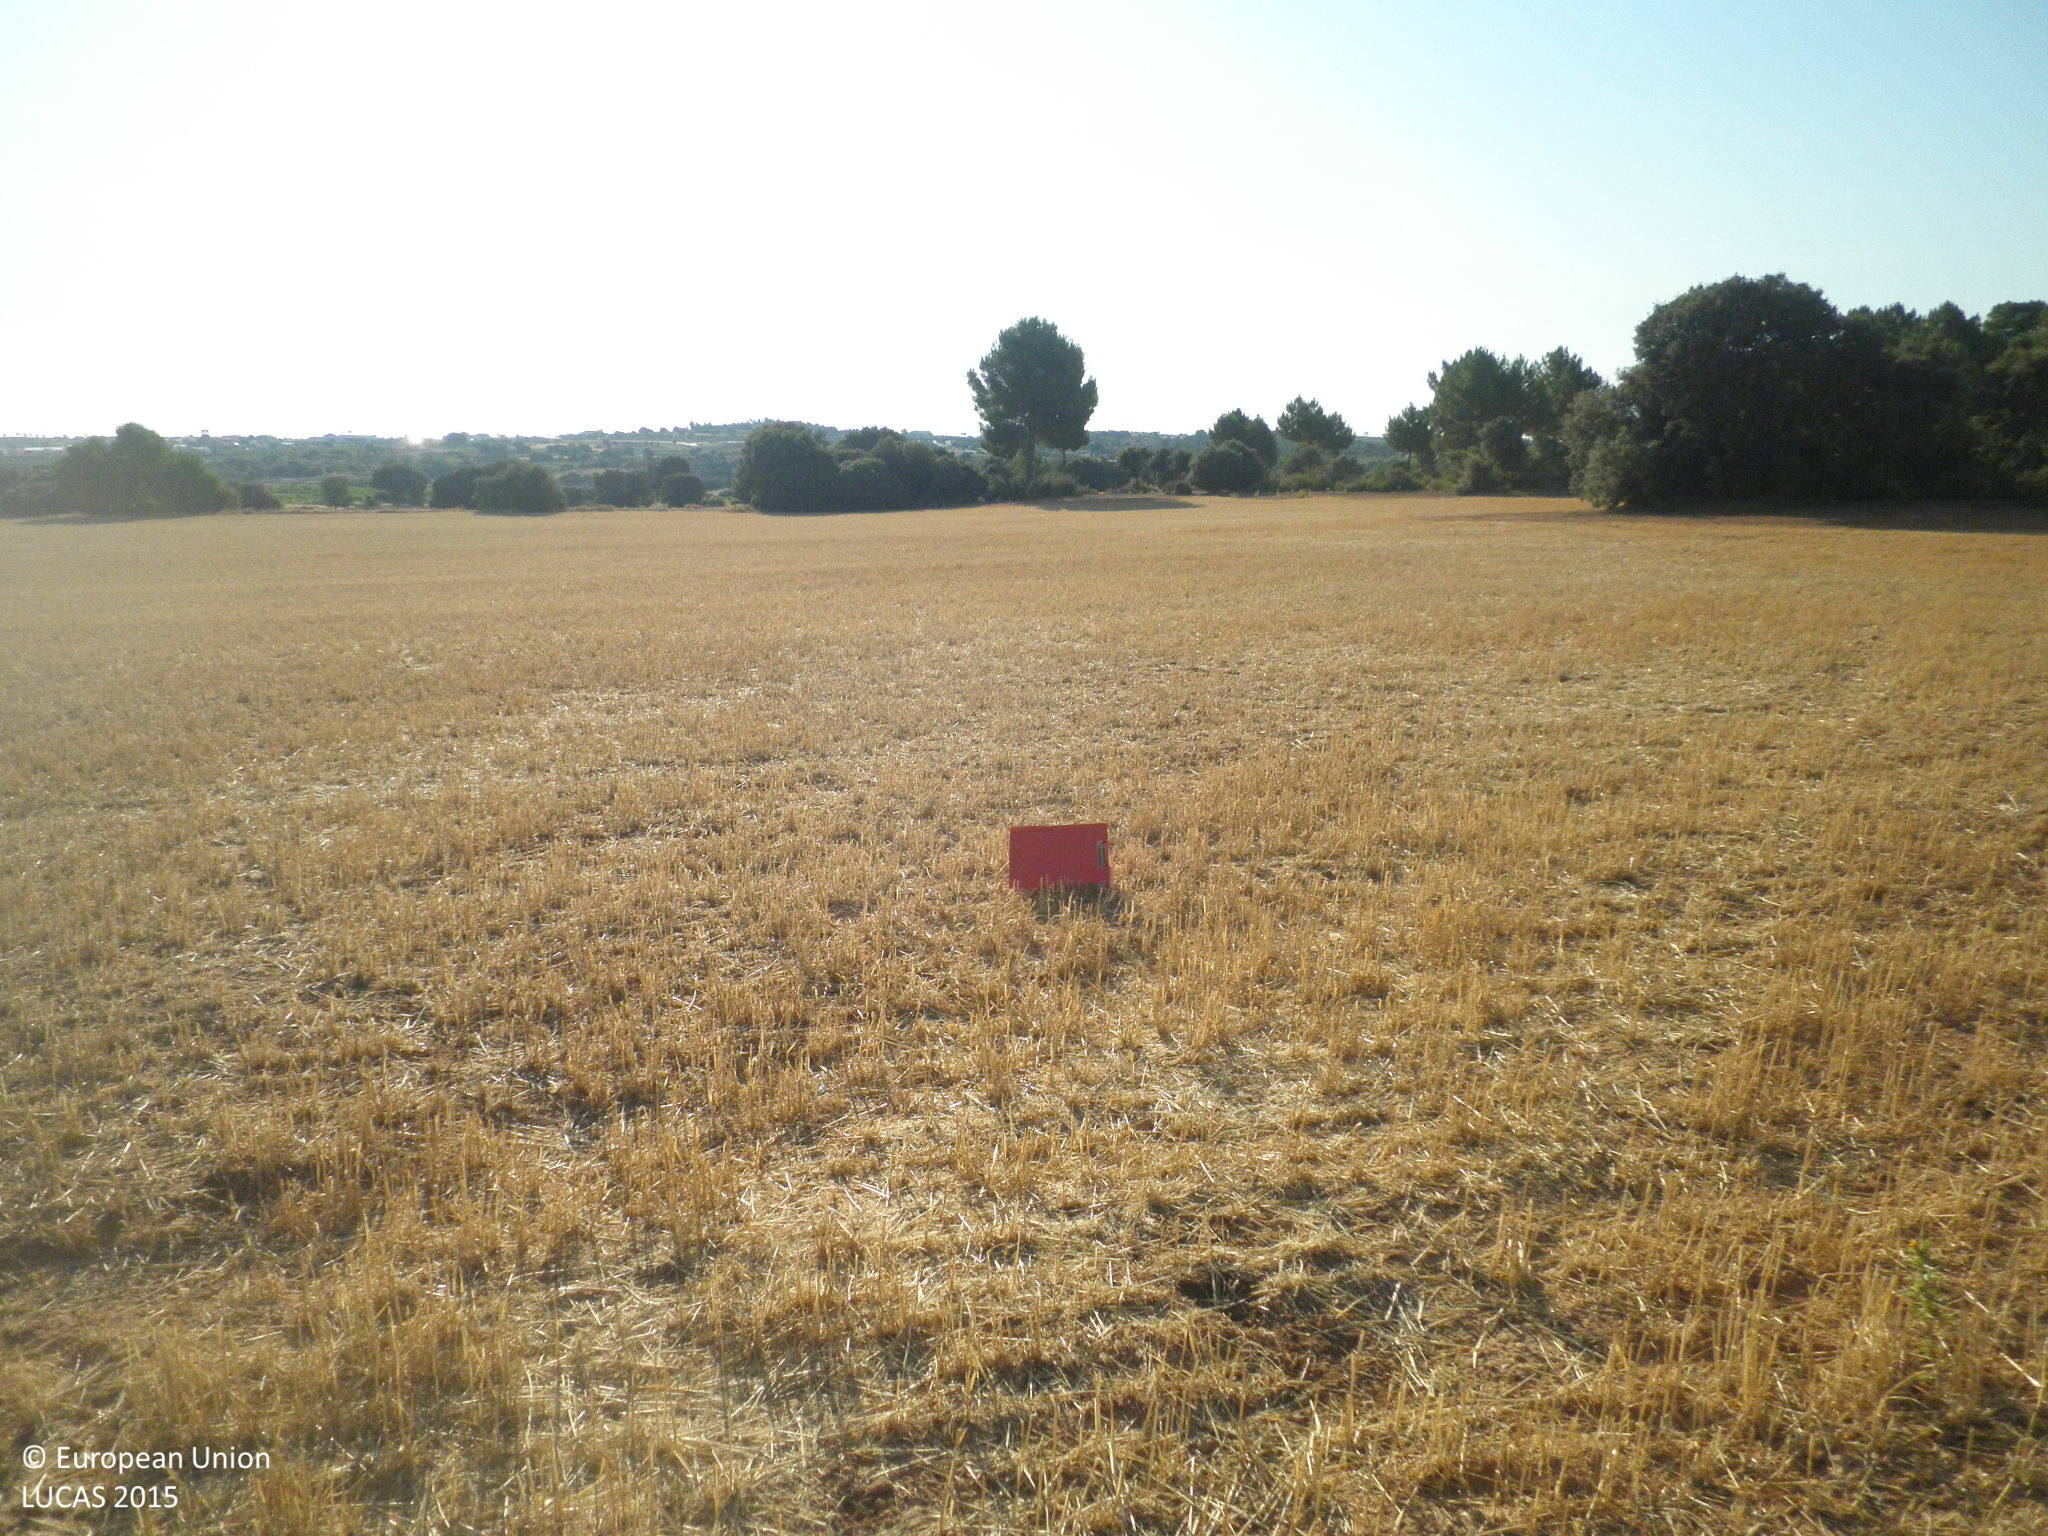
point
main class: Cropland
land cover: Barley
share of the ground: < 10 %
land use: Agriculture (excluding fallow land and kitchen gardens)
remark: Harvested field
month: July
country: ES
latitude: 39.5106
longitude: -1.6944
